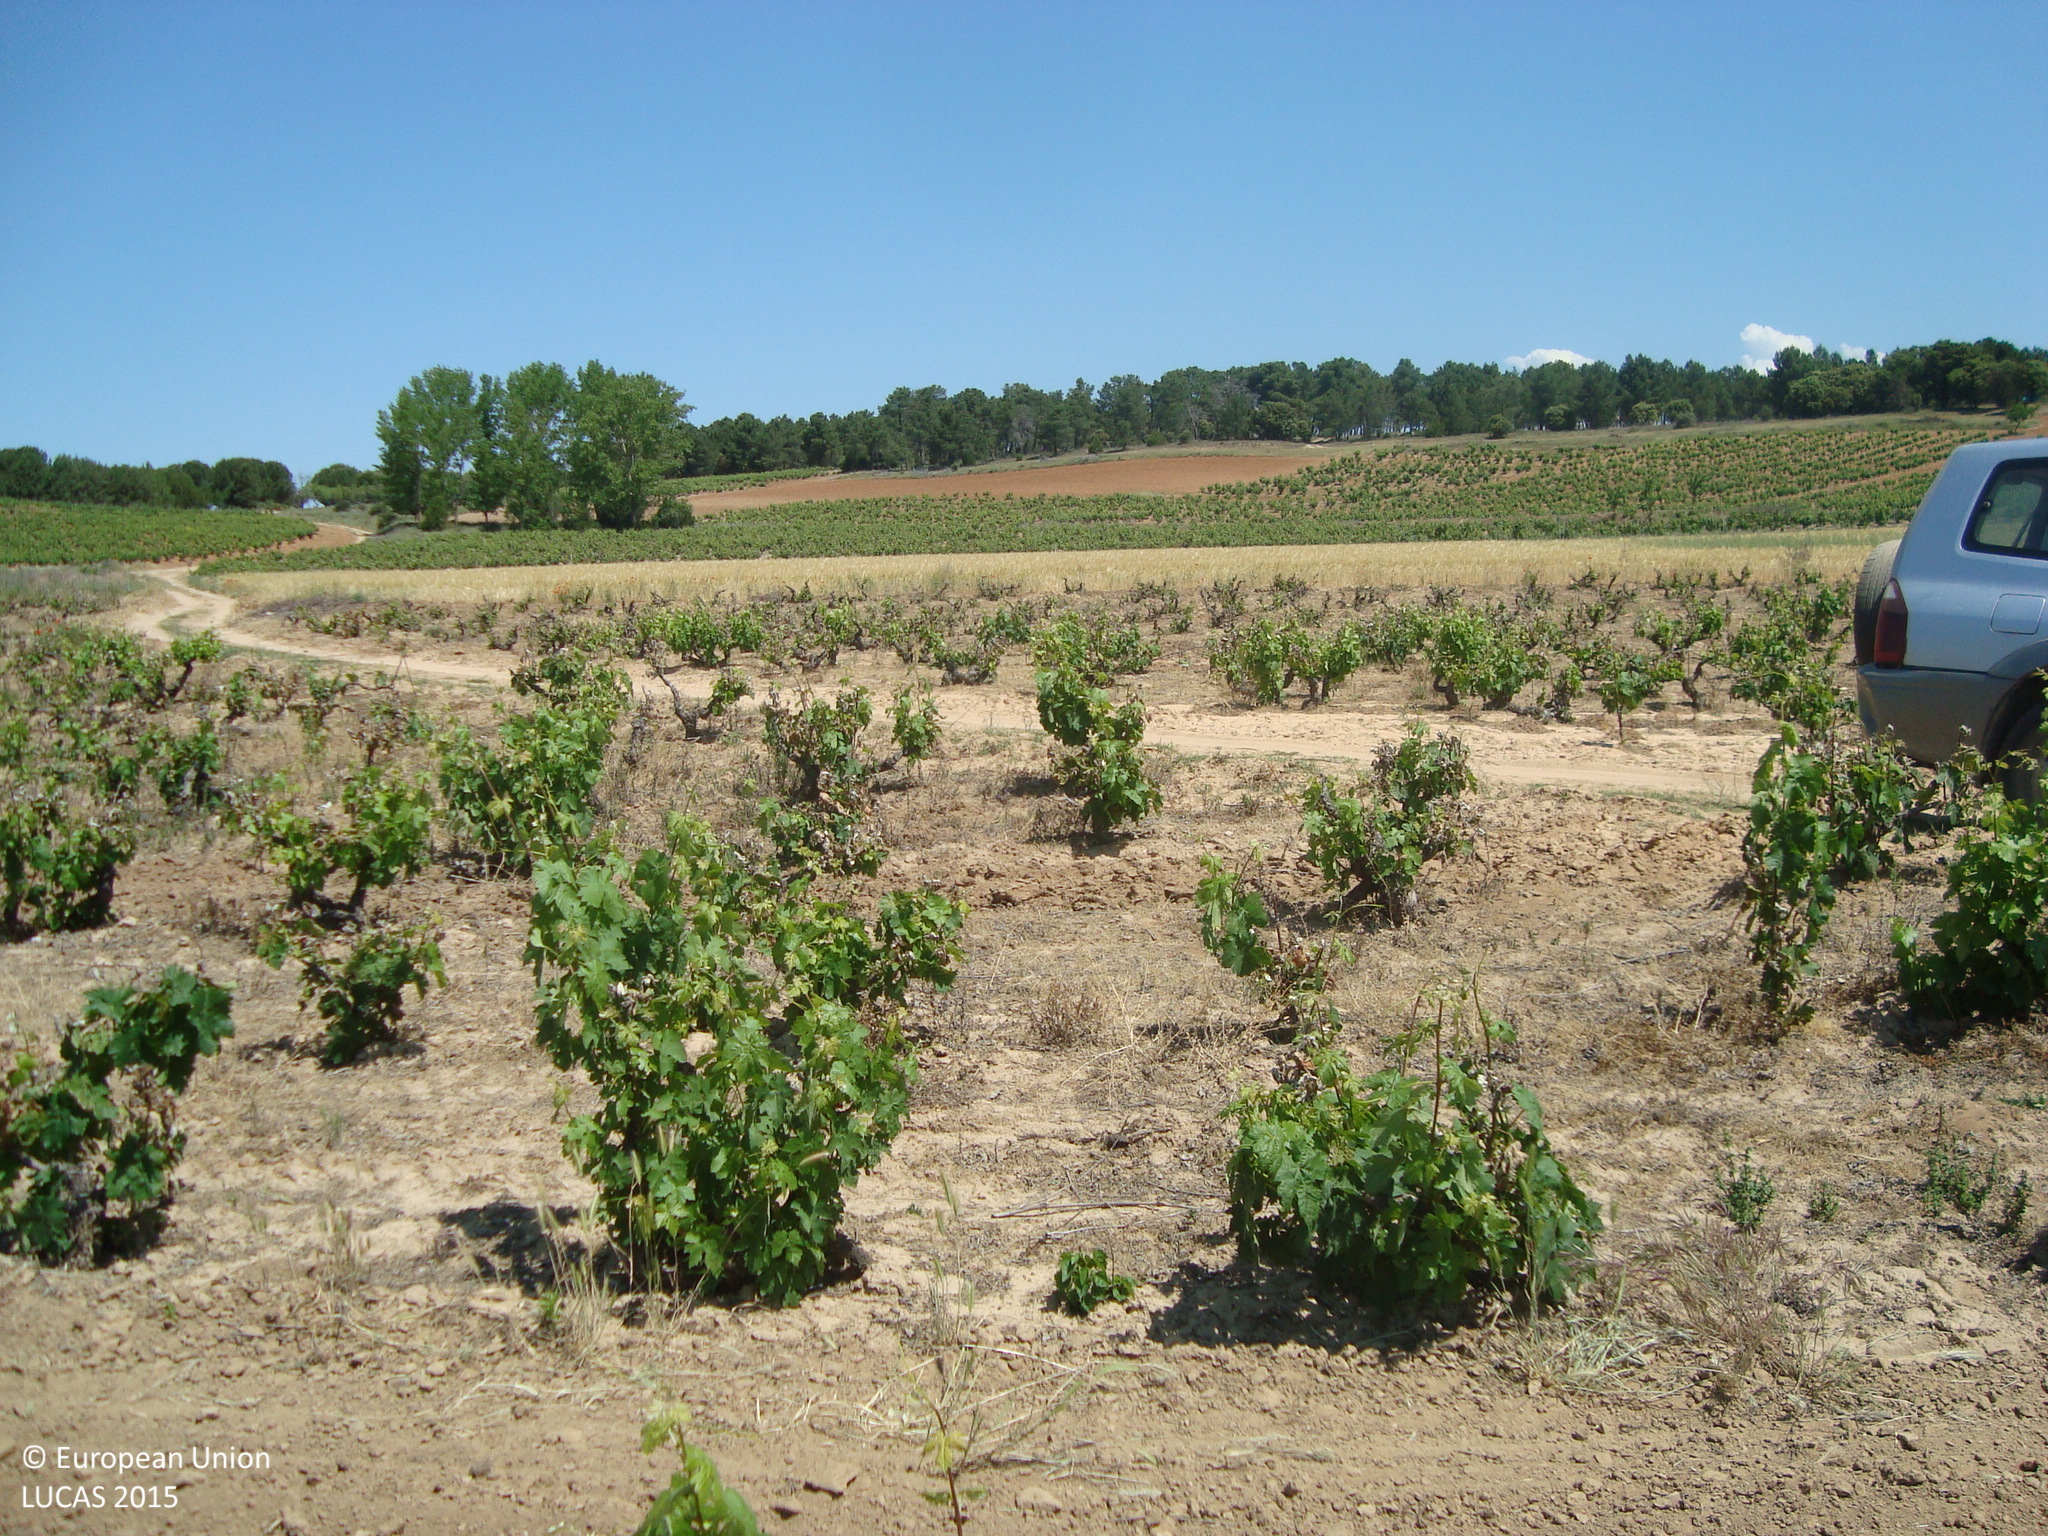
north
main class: Cropland
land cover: Vineyards
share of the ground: 10 - 25 %
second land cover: Other bare soil
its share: > 75 %
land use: Agriculture (excluding fallow land and kitchen gardens)
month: June
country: ES
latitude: 41.7172
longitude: -3.5738
